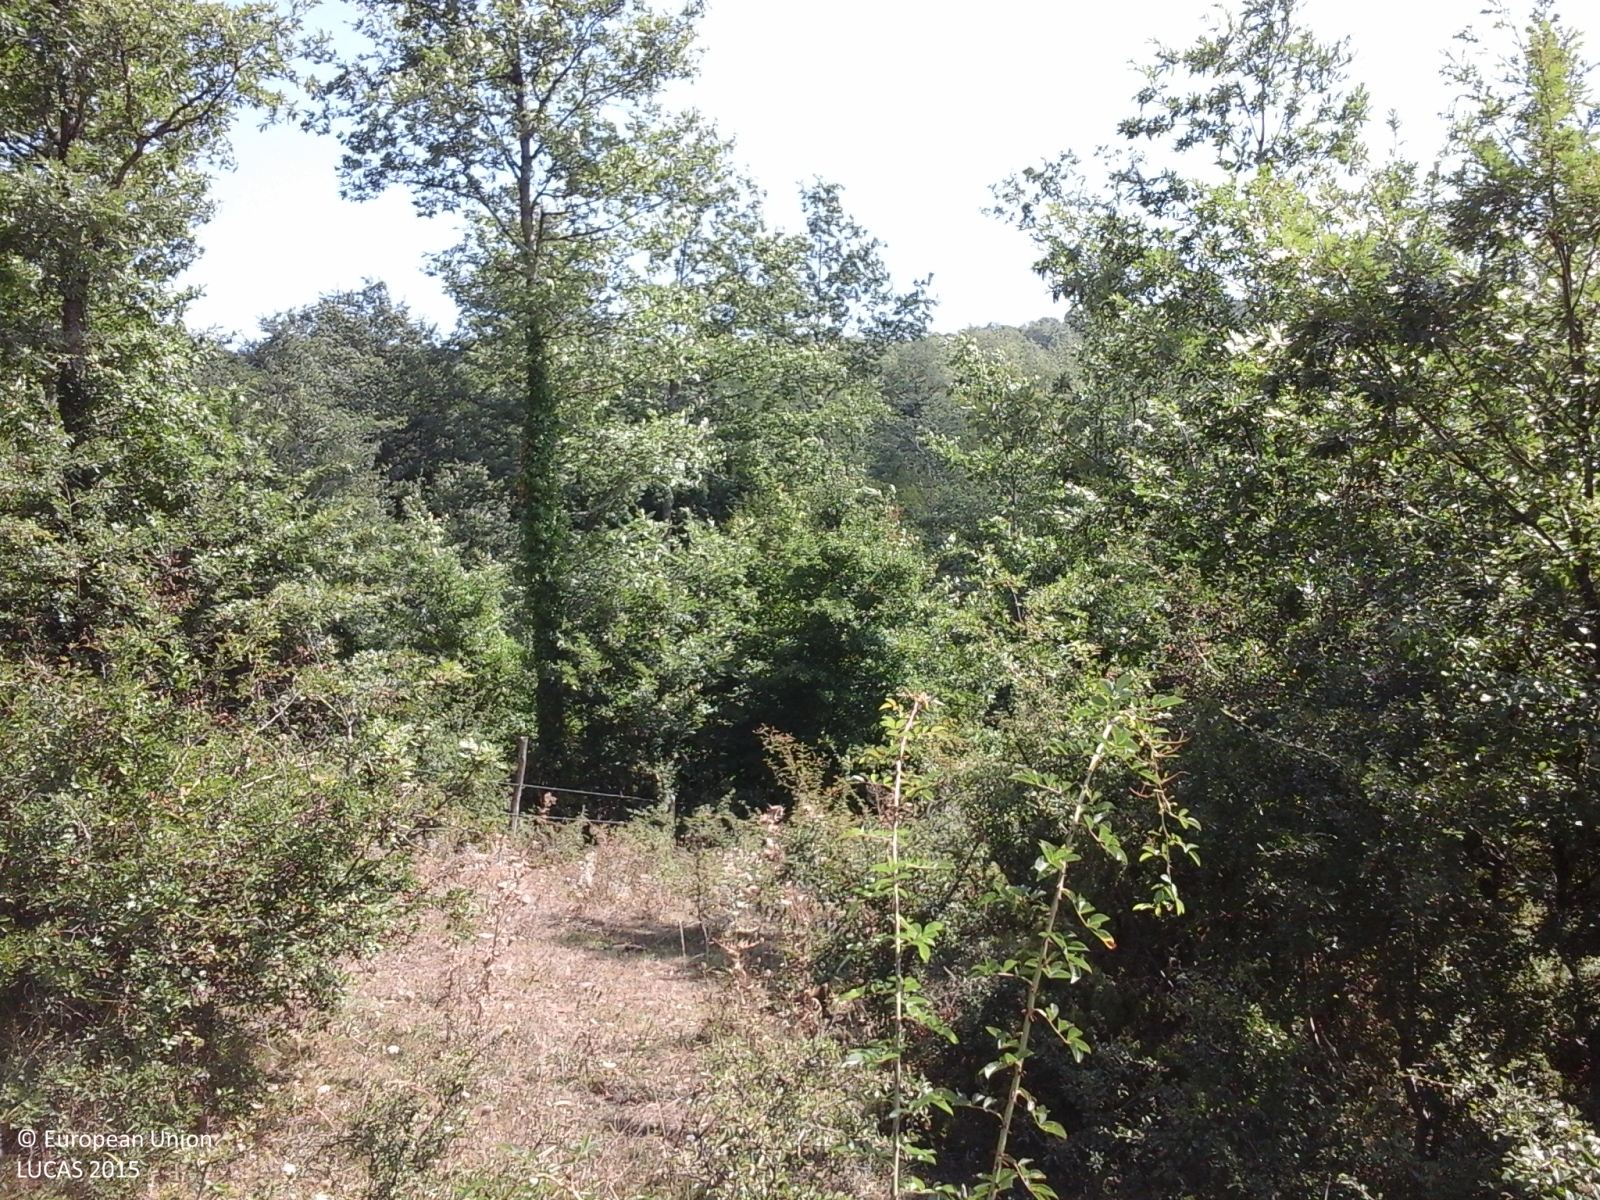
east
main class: Shrubland
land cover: Shrubland with sparse tree cover
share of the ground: > 75 %
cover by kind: herbaceous plants 50 %, shrubs 45 %, broadleaved forest trees 5 %
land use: Agriculture (excluding fallow land and kitchen gardens)
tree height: < 5 m
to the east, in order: Shrubland with sparse tree cover; Fences; Broadleaved woodland
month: August
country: IT
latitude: 41.7666
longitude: 14.3036
